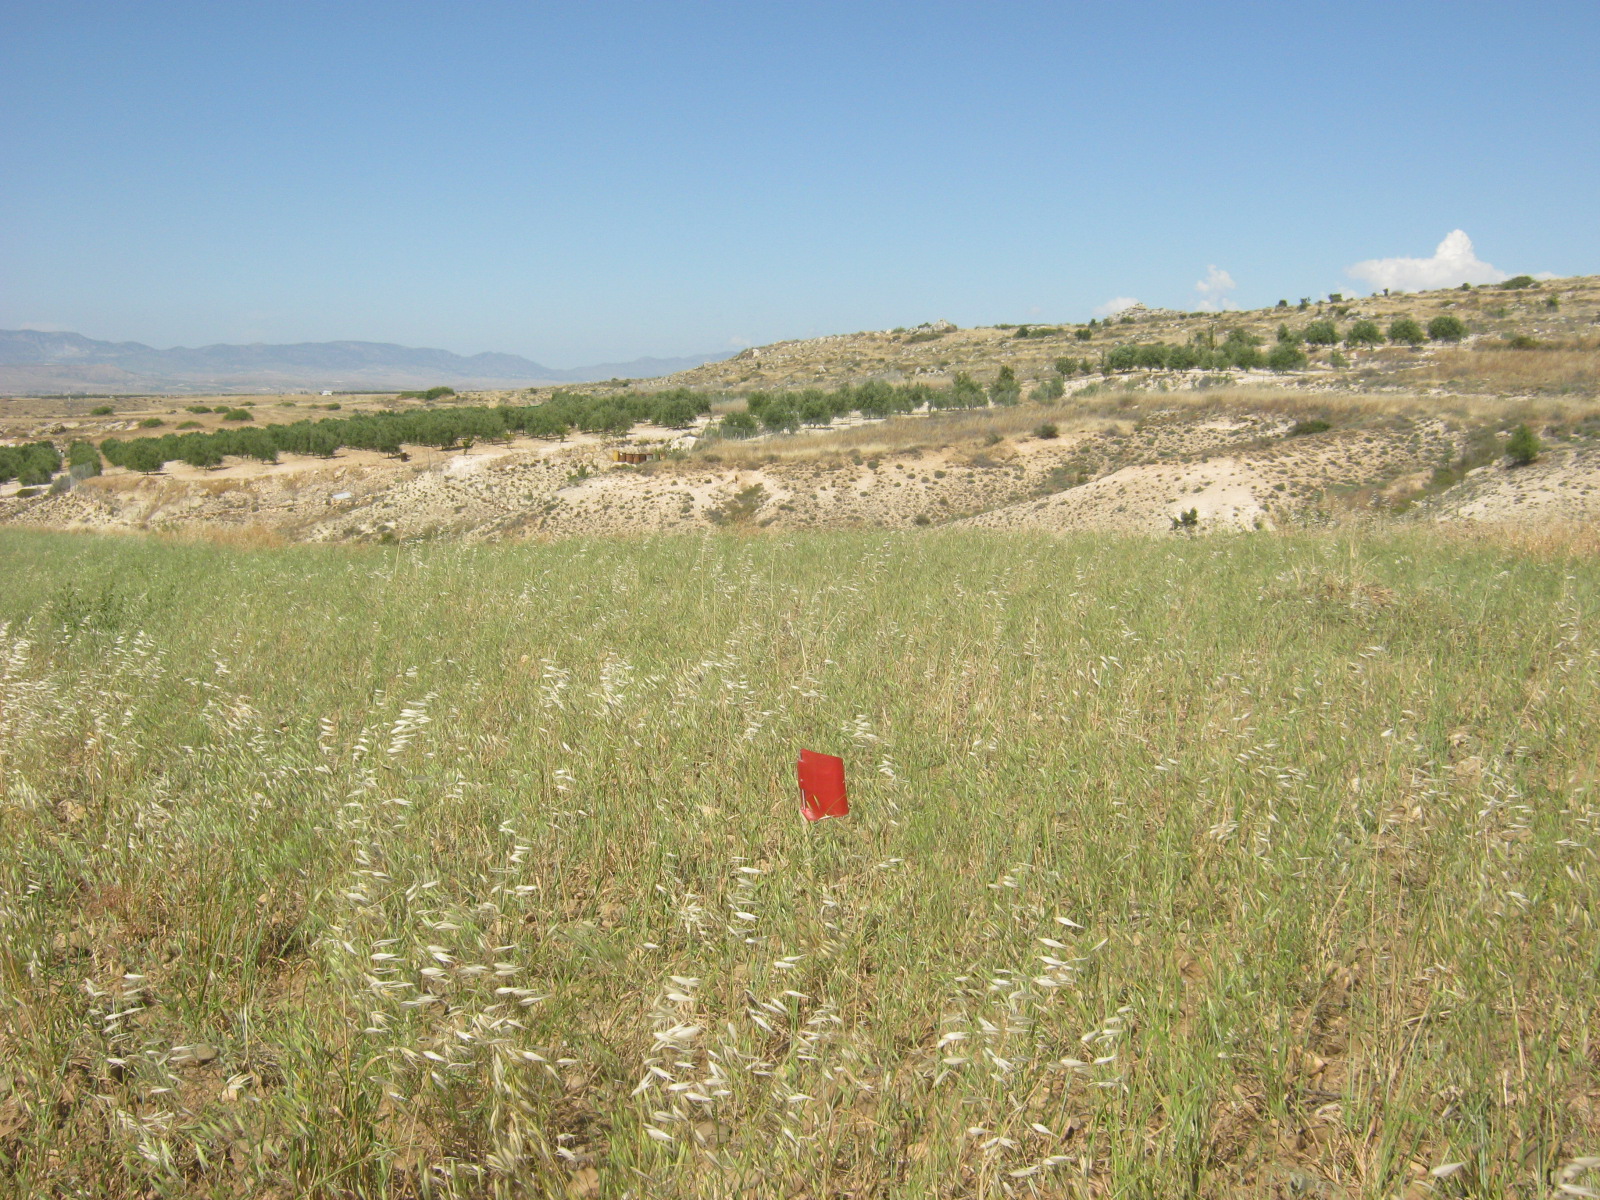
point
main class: Grassland
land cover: Spontaneously vegetated surfaces
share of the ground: > 75 %
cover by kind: herbaceous plants 80 %, unconsolidated bare surface 20 %
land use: Fallow land
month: May
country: CY
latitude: 35.0876
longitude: 33.0251
